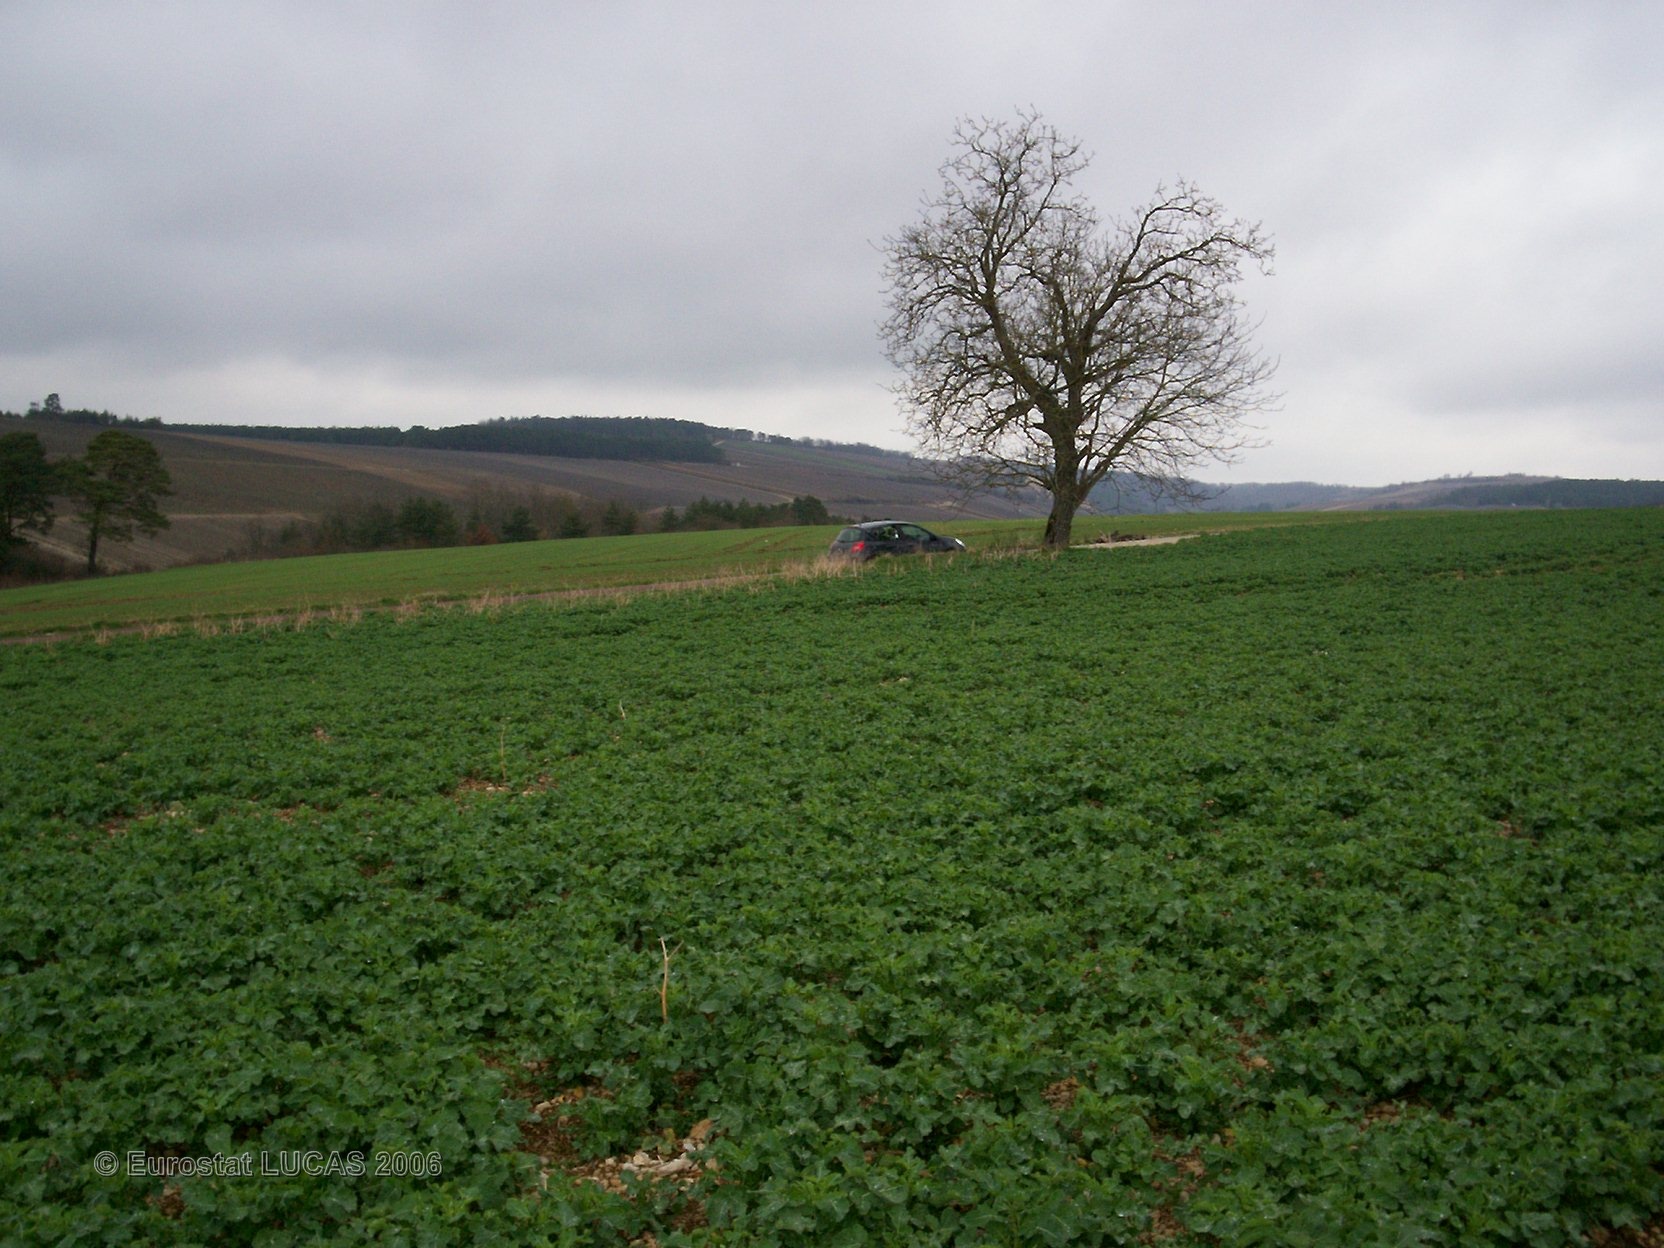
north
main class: Cropland
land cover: Rape and turnip rape
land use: Agriculture (excluding fallow land and kitchen gardens)
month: April
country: FR
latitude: 48.0687
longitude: 4.5090
